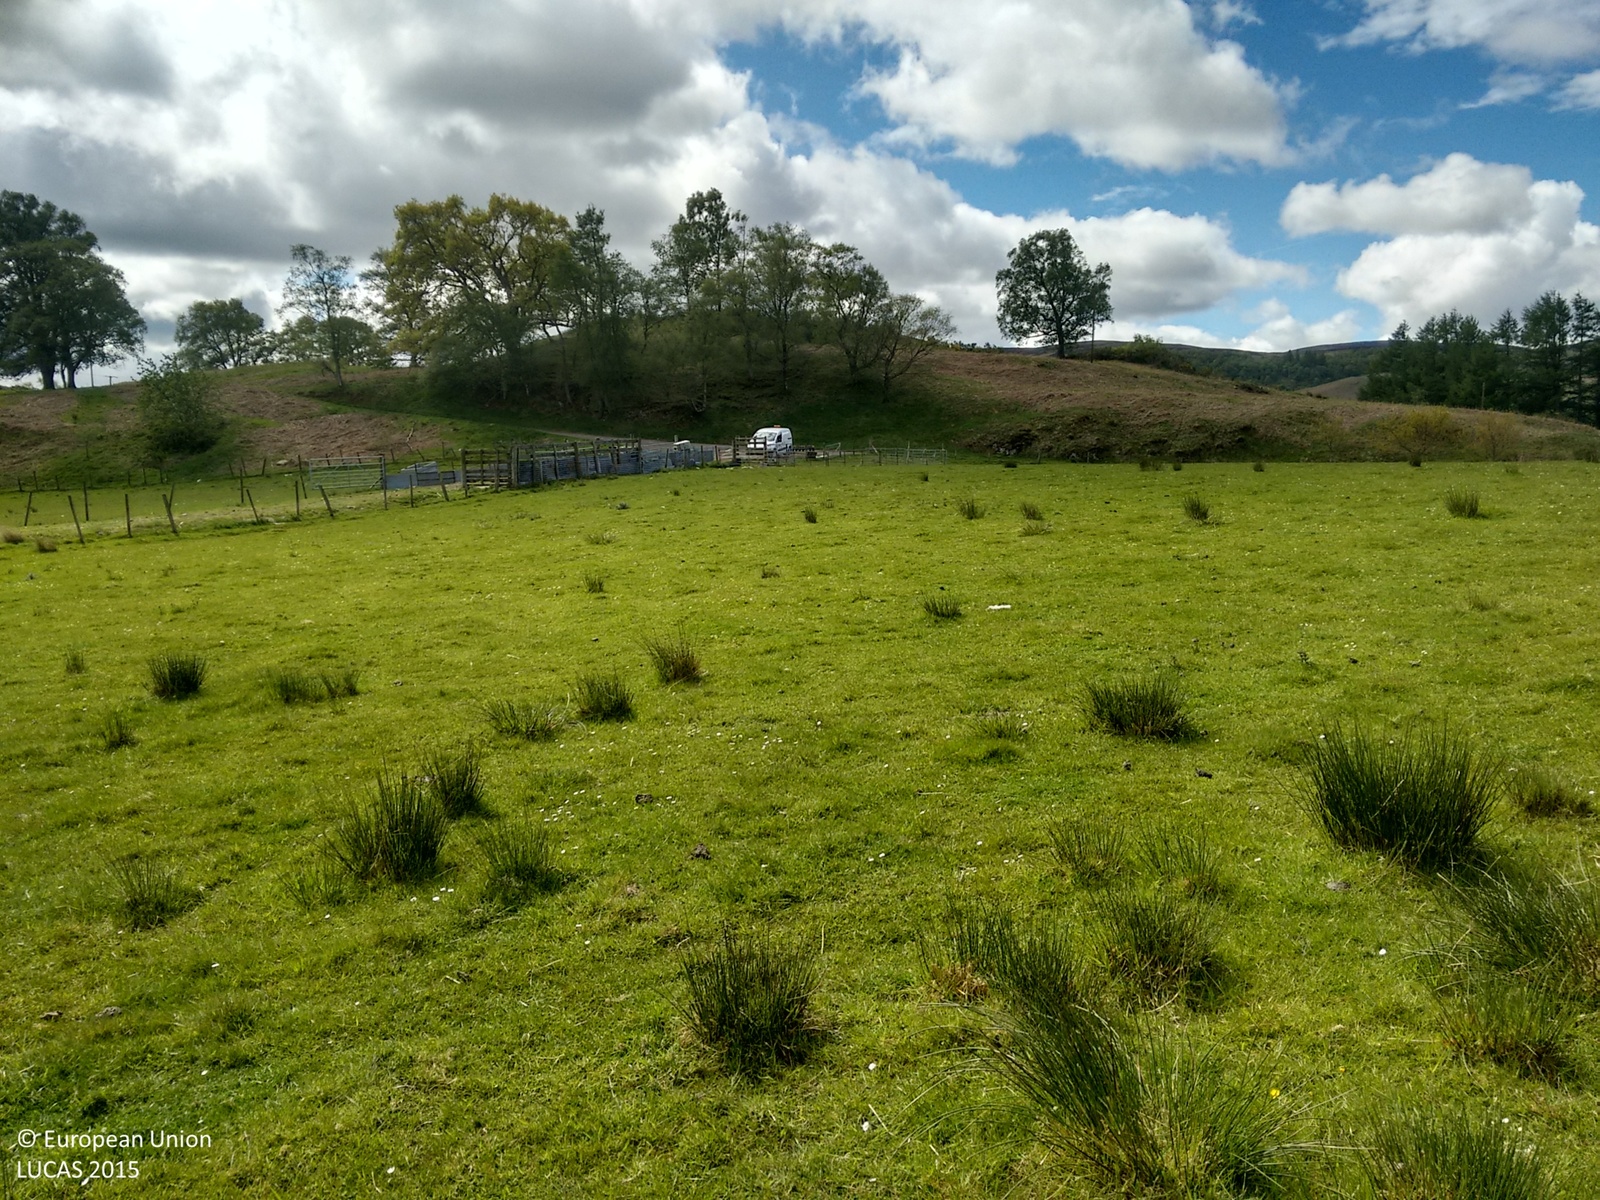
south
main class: Grassland
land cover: Grassland without tree/shrub cover
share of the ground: > 75 %
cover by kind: herbaceous plants 100 %
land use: Agriculture (excluding fallow land and kitchen gardens)
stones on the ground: < 10 %
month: May
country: GB
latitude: 56.3491
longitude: -3.9850
